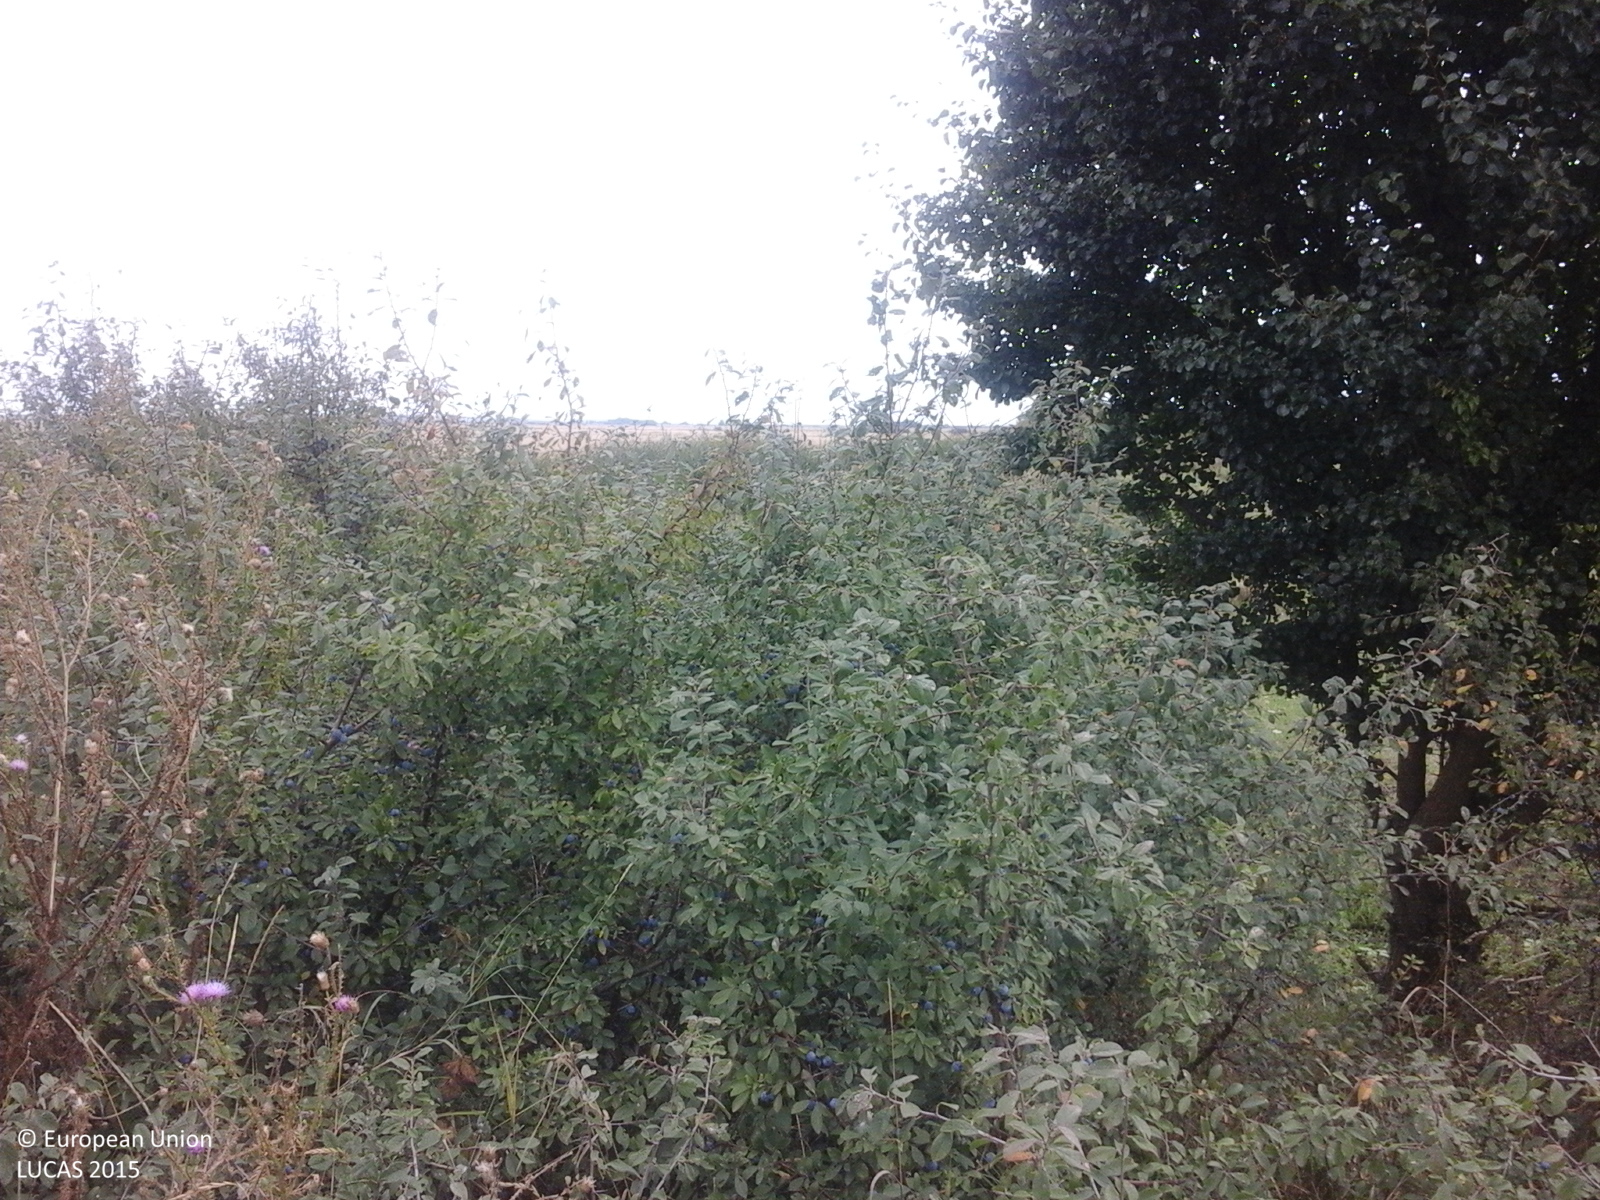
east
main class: Grassland
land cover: Grassland without tree/shrub cover
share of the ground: > 75 %
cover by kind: herbaceous plants 100 %
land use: Agriculture (excluding fallow land and kitchen gardens)
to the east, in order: Grassland without tree/shrub cover; Shrubland without tree cover; Ditches and canals; Spontaneously vegetated surfaces; Grassland without tree/shrub cover
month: August
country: RO
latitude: 45.4413
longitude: 20.9565
